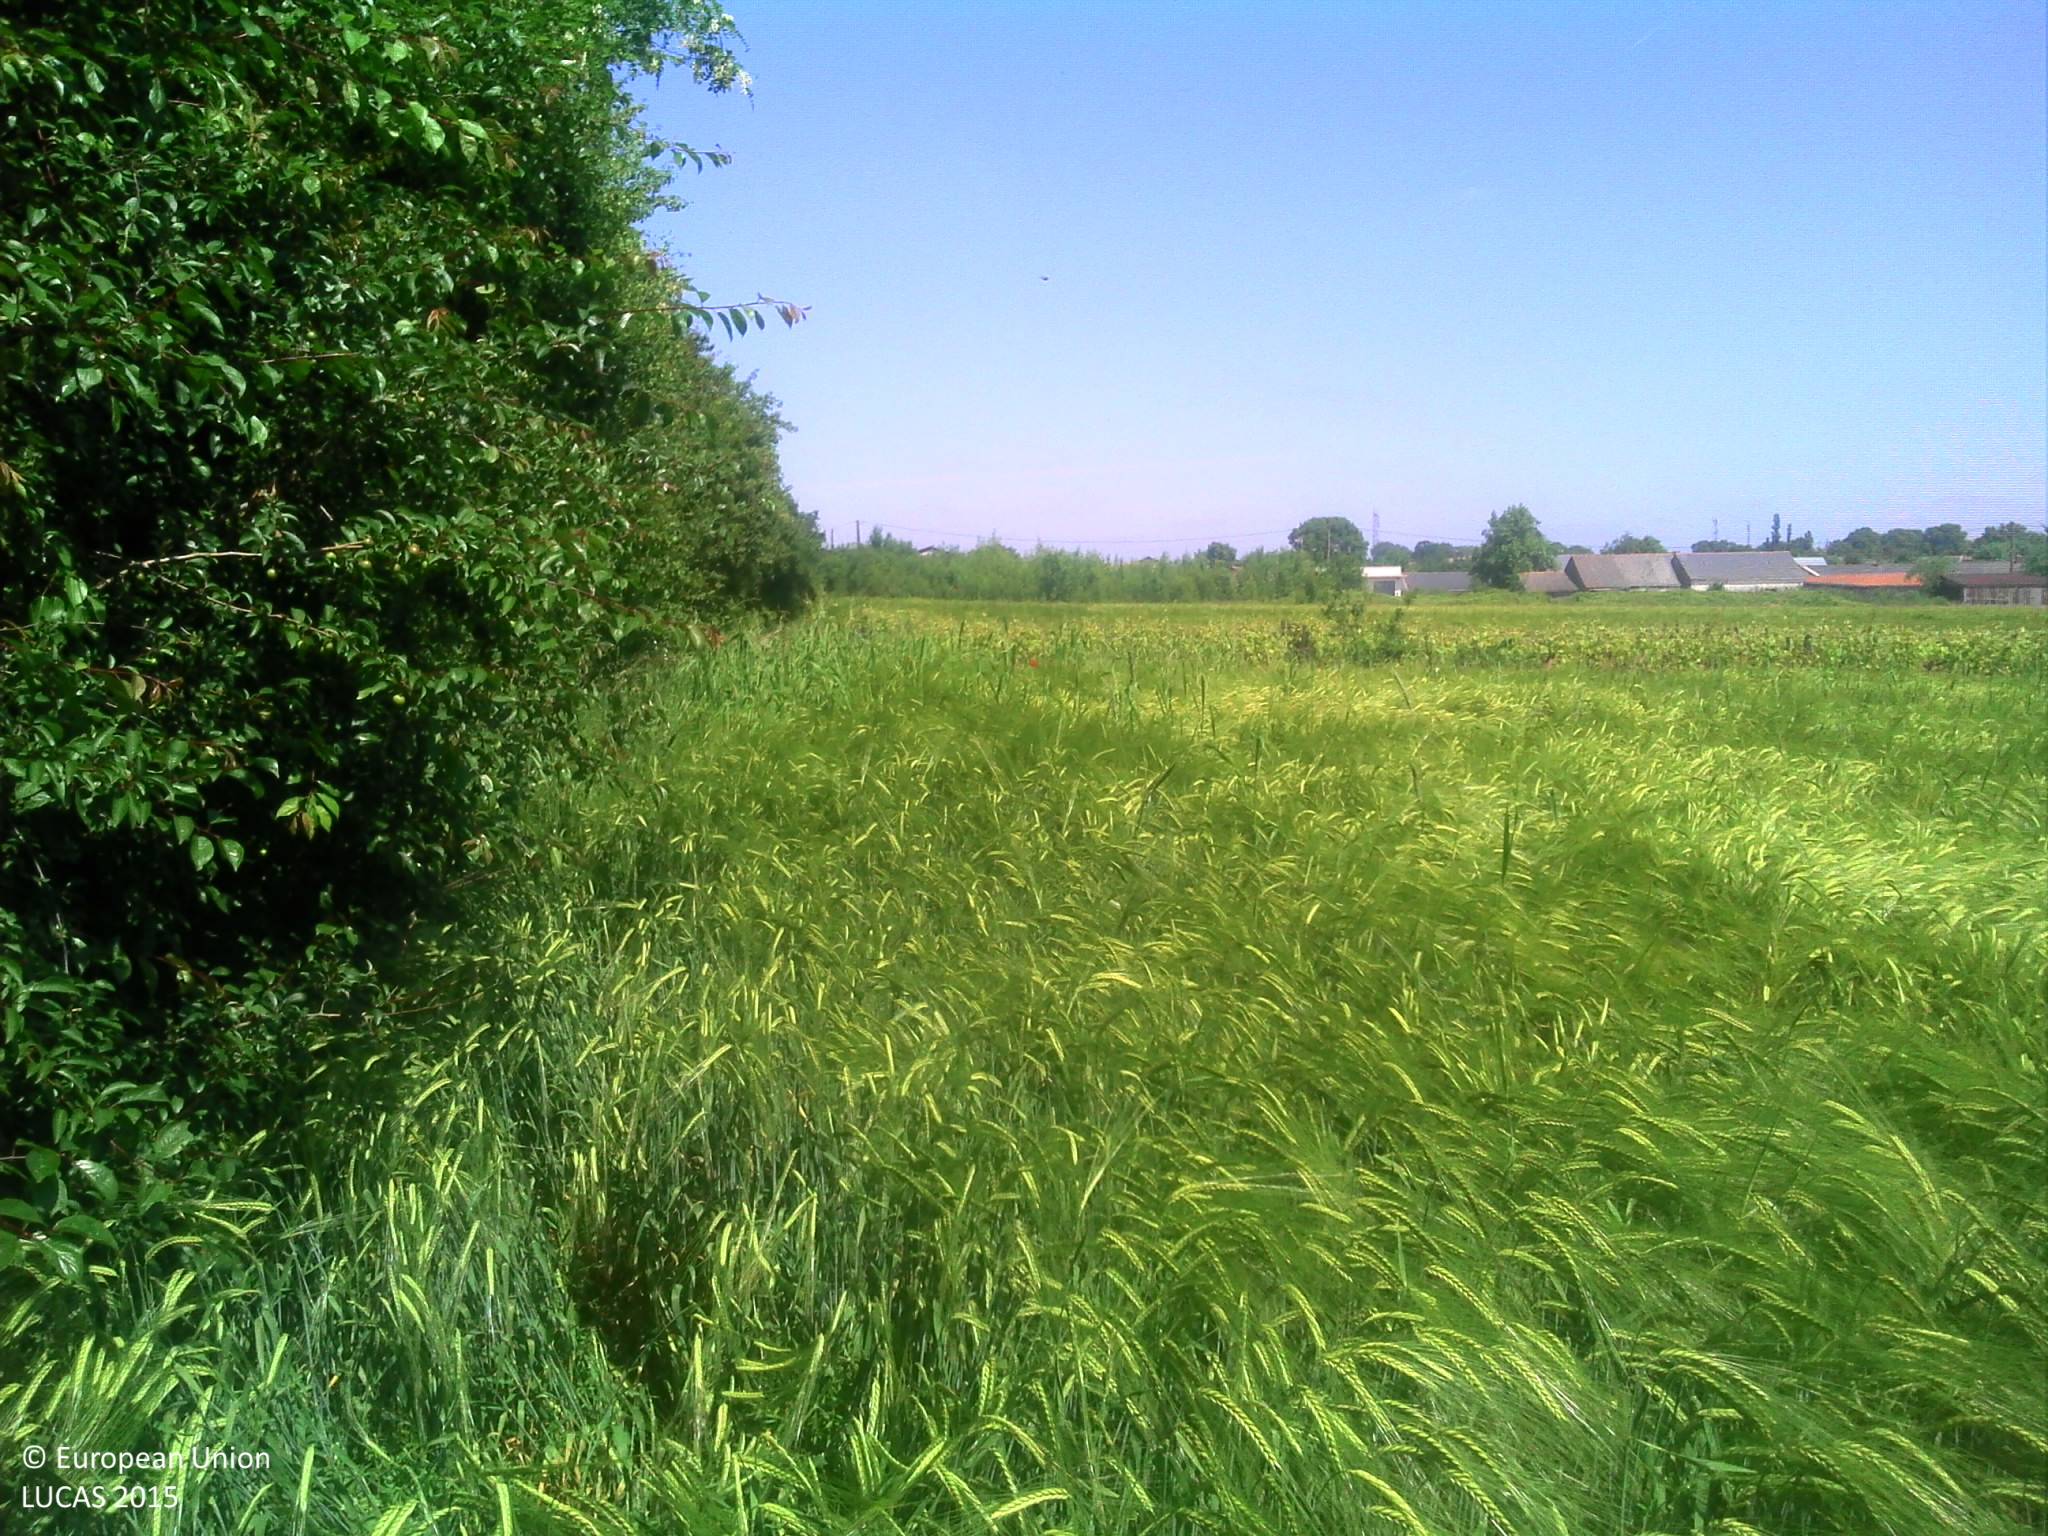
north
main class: Cropland
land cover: Barley
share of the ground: > 75 %
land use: Agriculture (excluding fallow land and kitchen gardens)
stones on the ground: < 10 %
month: May
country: FR
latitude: 47.4119
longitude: -1.0502
